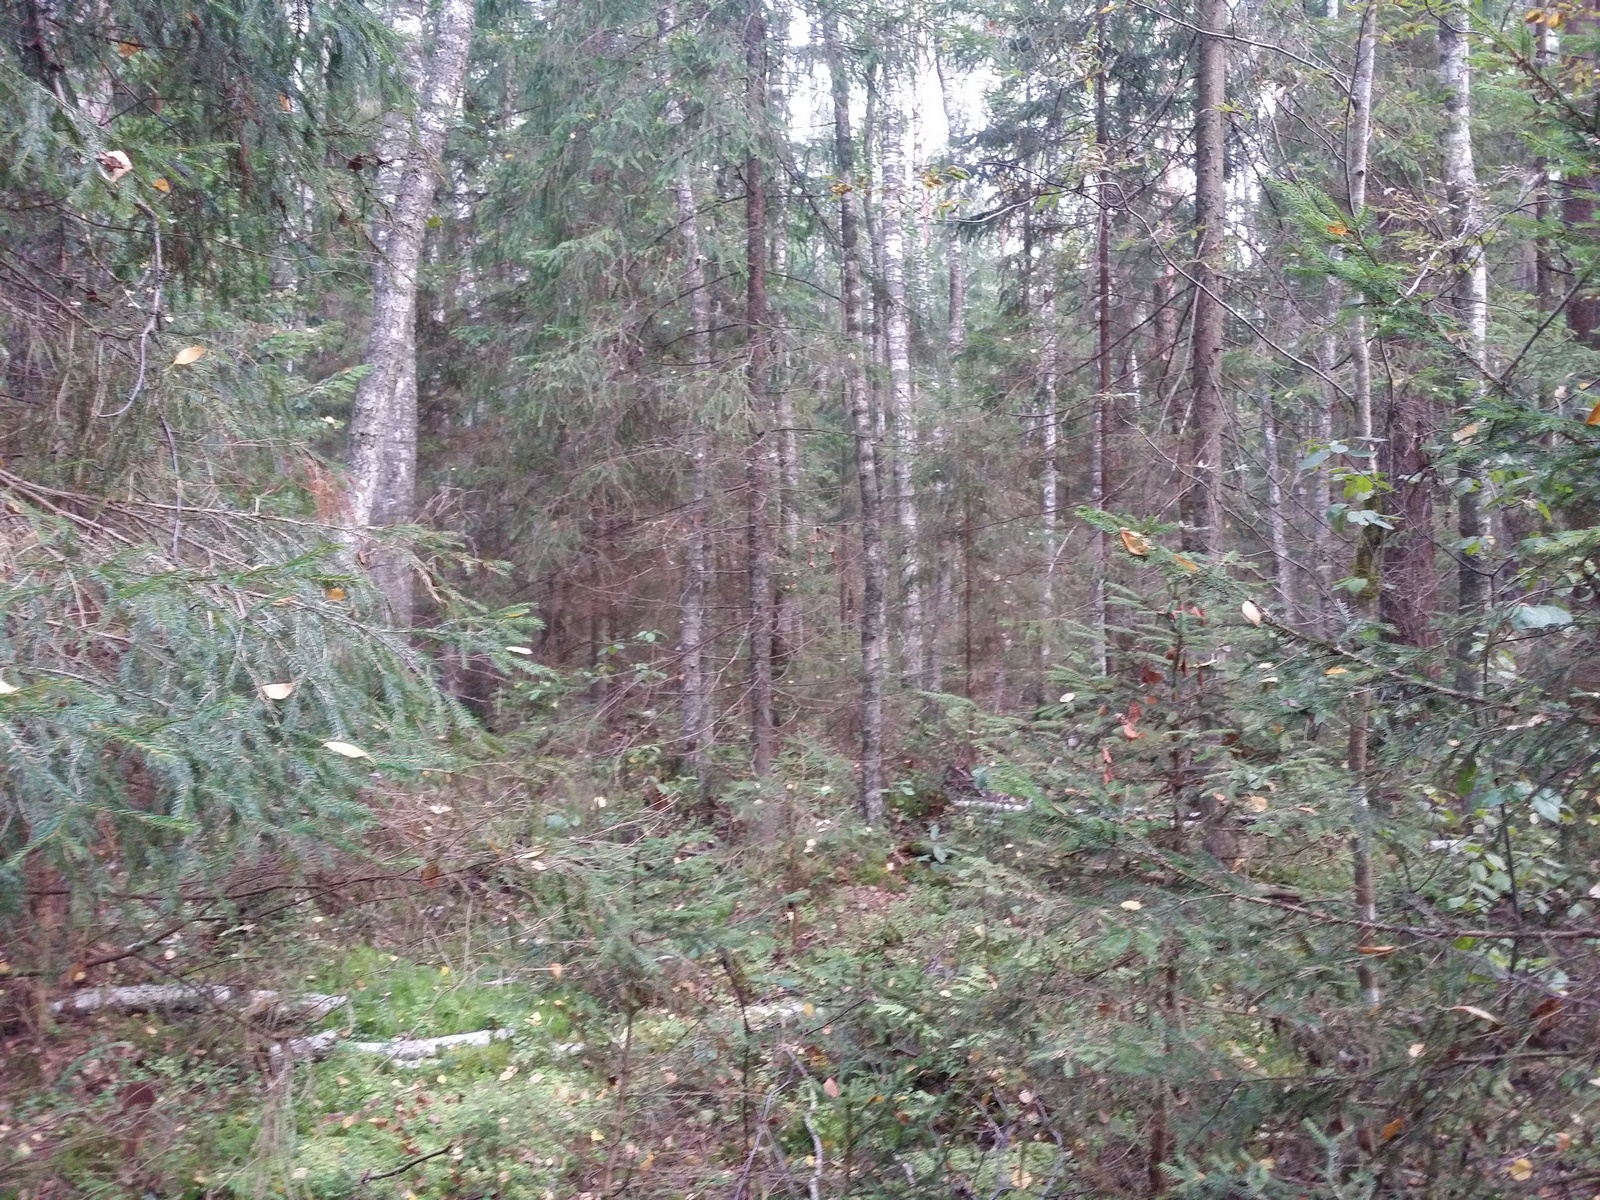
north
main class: Woodland
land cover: Spruce dominated coniferous woodland
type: hemiboreal forest and nemoral coniferous forest and mixed broadleaved-coniferous forest
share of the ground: > 75 %
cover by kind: coniferous forest trees 65 %, broadleaved forest trees 20 %, lichens and mosses 15 %
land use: Forestry
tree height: > 5 m
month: September
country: LV
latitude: 57.1558
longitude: 27.5868
